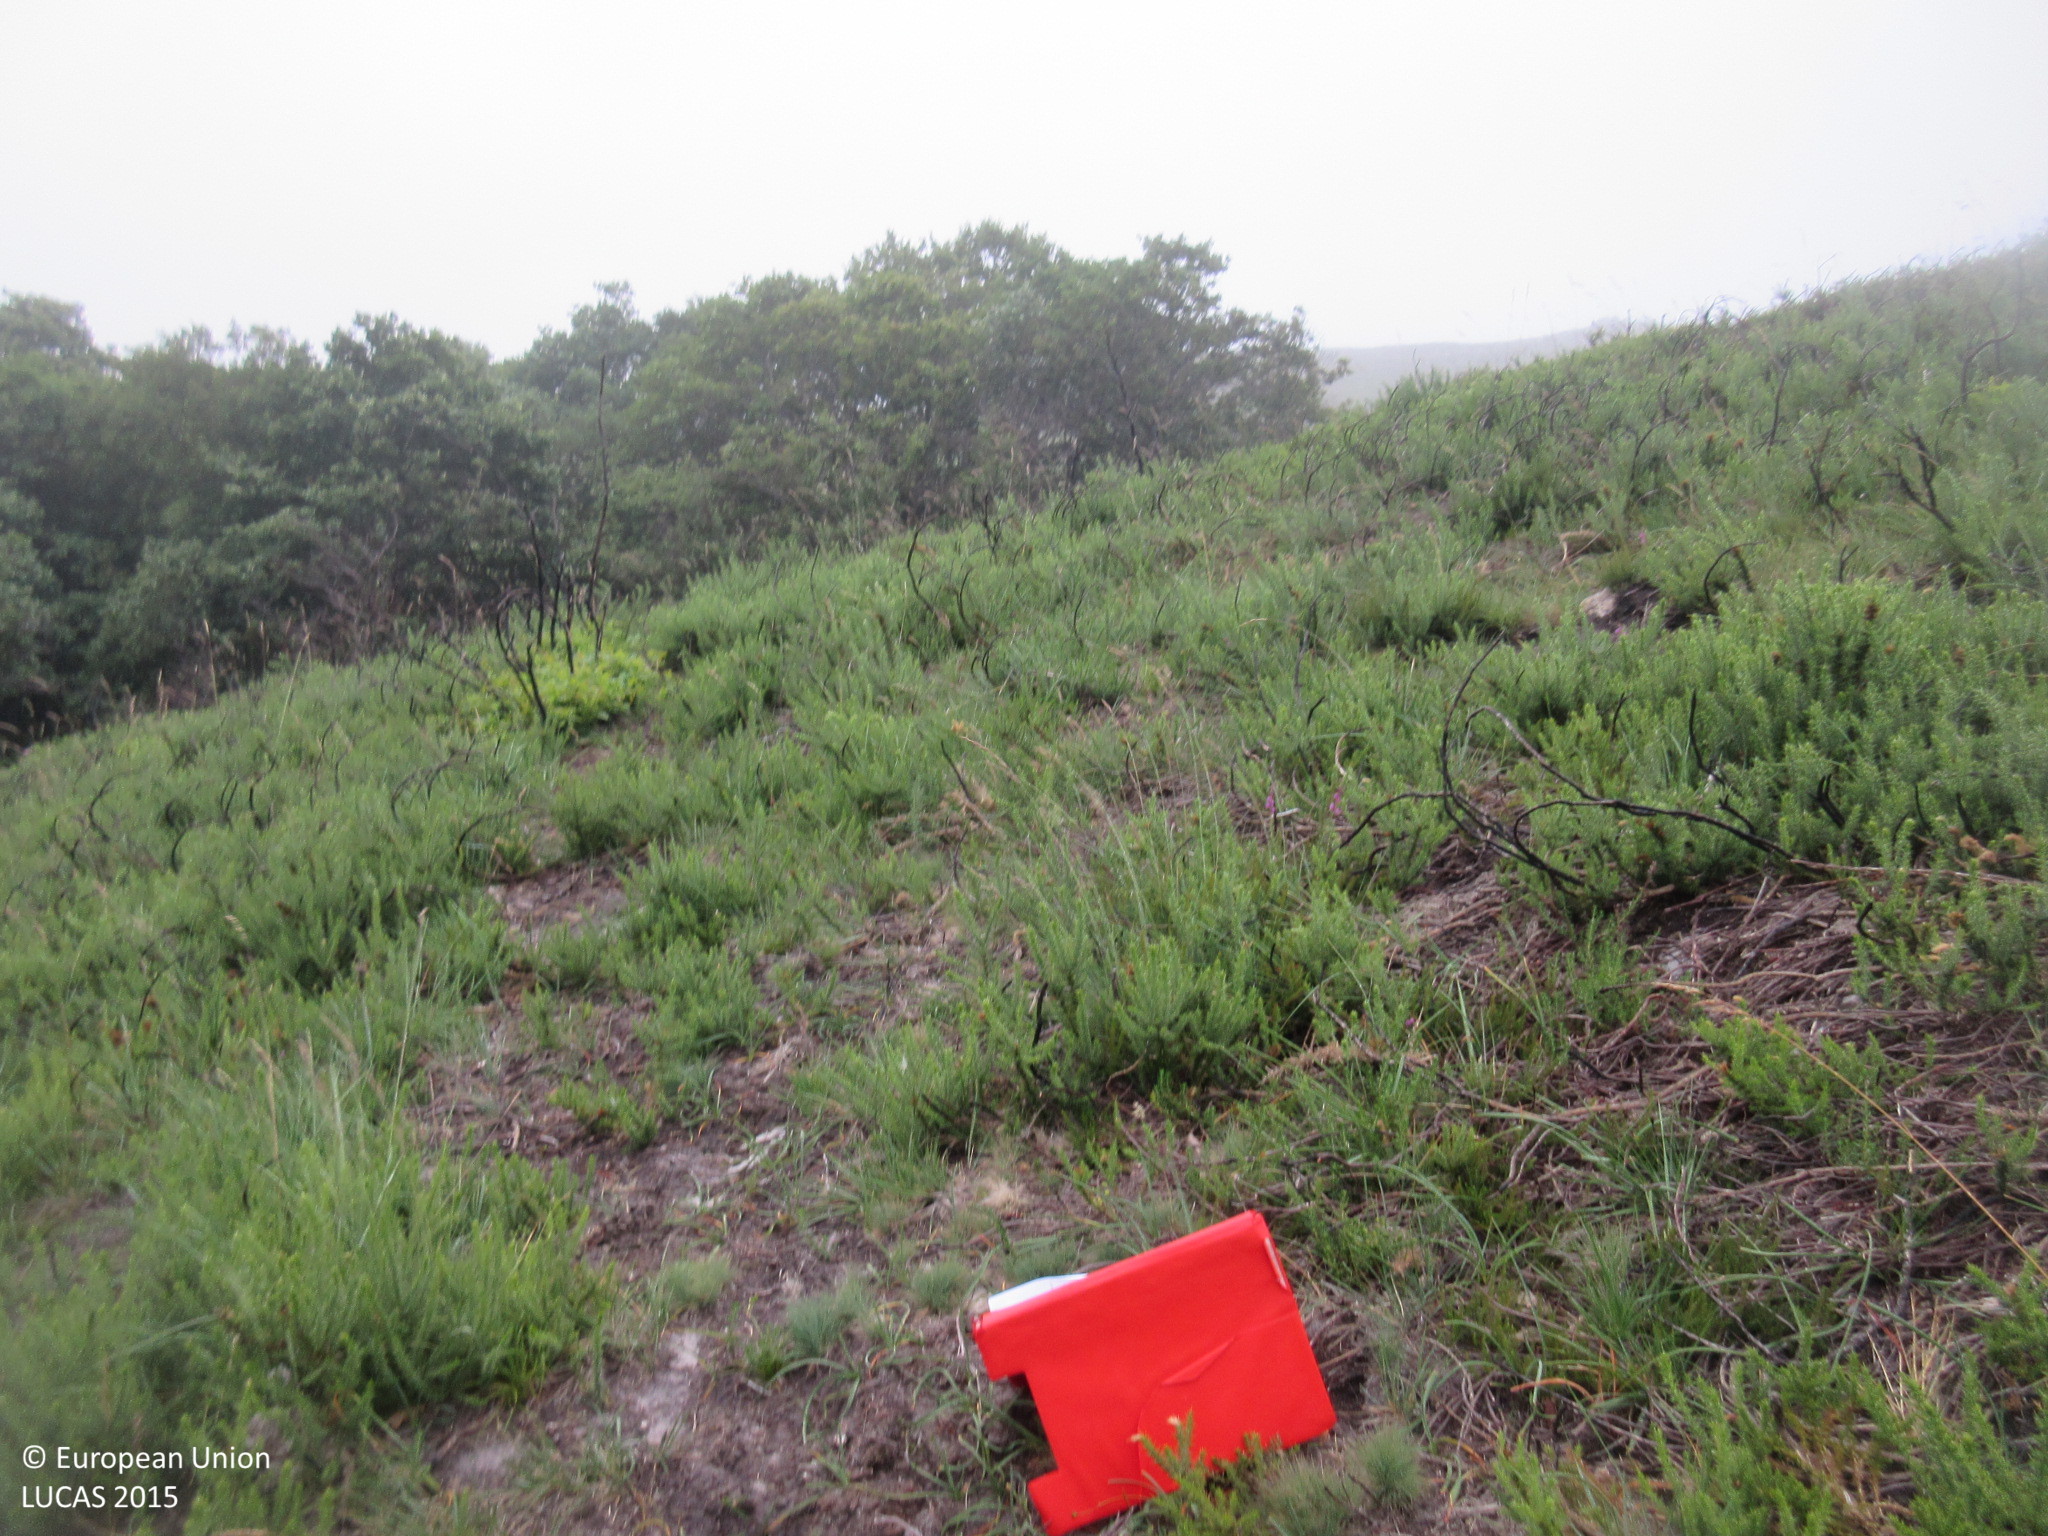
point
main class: Shrubland
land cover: Shrubland without tree cover
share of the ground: > 75 %
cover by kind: shrubs 75 %, herbaceous plants 20 %, unconsolidated bare surface 5 %
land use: Agriculture (excluding fallow land and kitchen gardens)
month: July
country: ES
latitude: 43.0433
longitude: -3.9056
